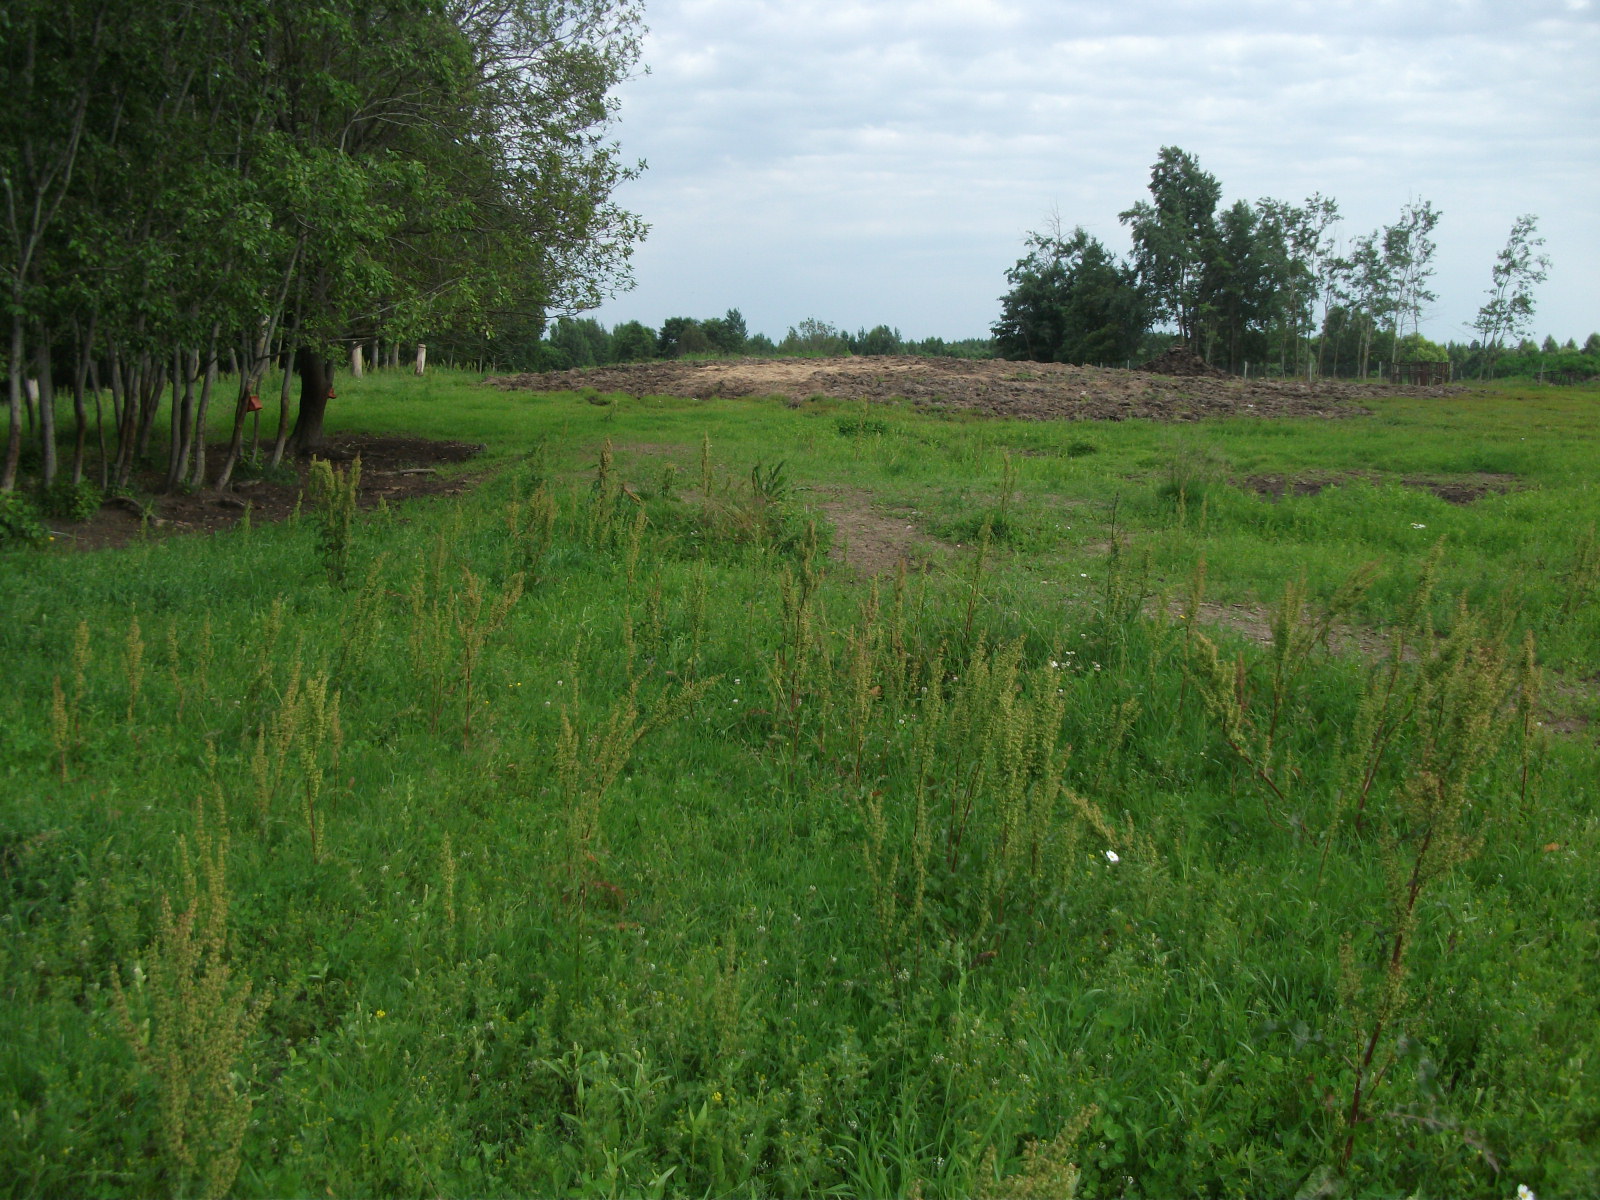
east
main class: Grassland
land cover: Grassland without tree/shrub cover
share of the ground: > 75 %
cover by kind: herbaceous plants 100 %
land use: Agriculture (excluding fallow land and kitchen gardens)
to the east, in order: Grassland without tree/shrub cover; Broadleaved woodland; Grassland without tree/shrub cover; Broadleaved woodland; Grassland without tree/shrub cover; Broadleaved woodland; Grassland without tree/shrub cover; Abandoned hedges; Ditches and canals; Abandoned hedges; Grassland without tree/shrub cover
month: July
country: LV
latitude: 57.1485
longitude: 26.5251
